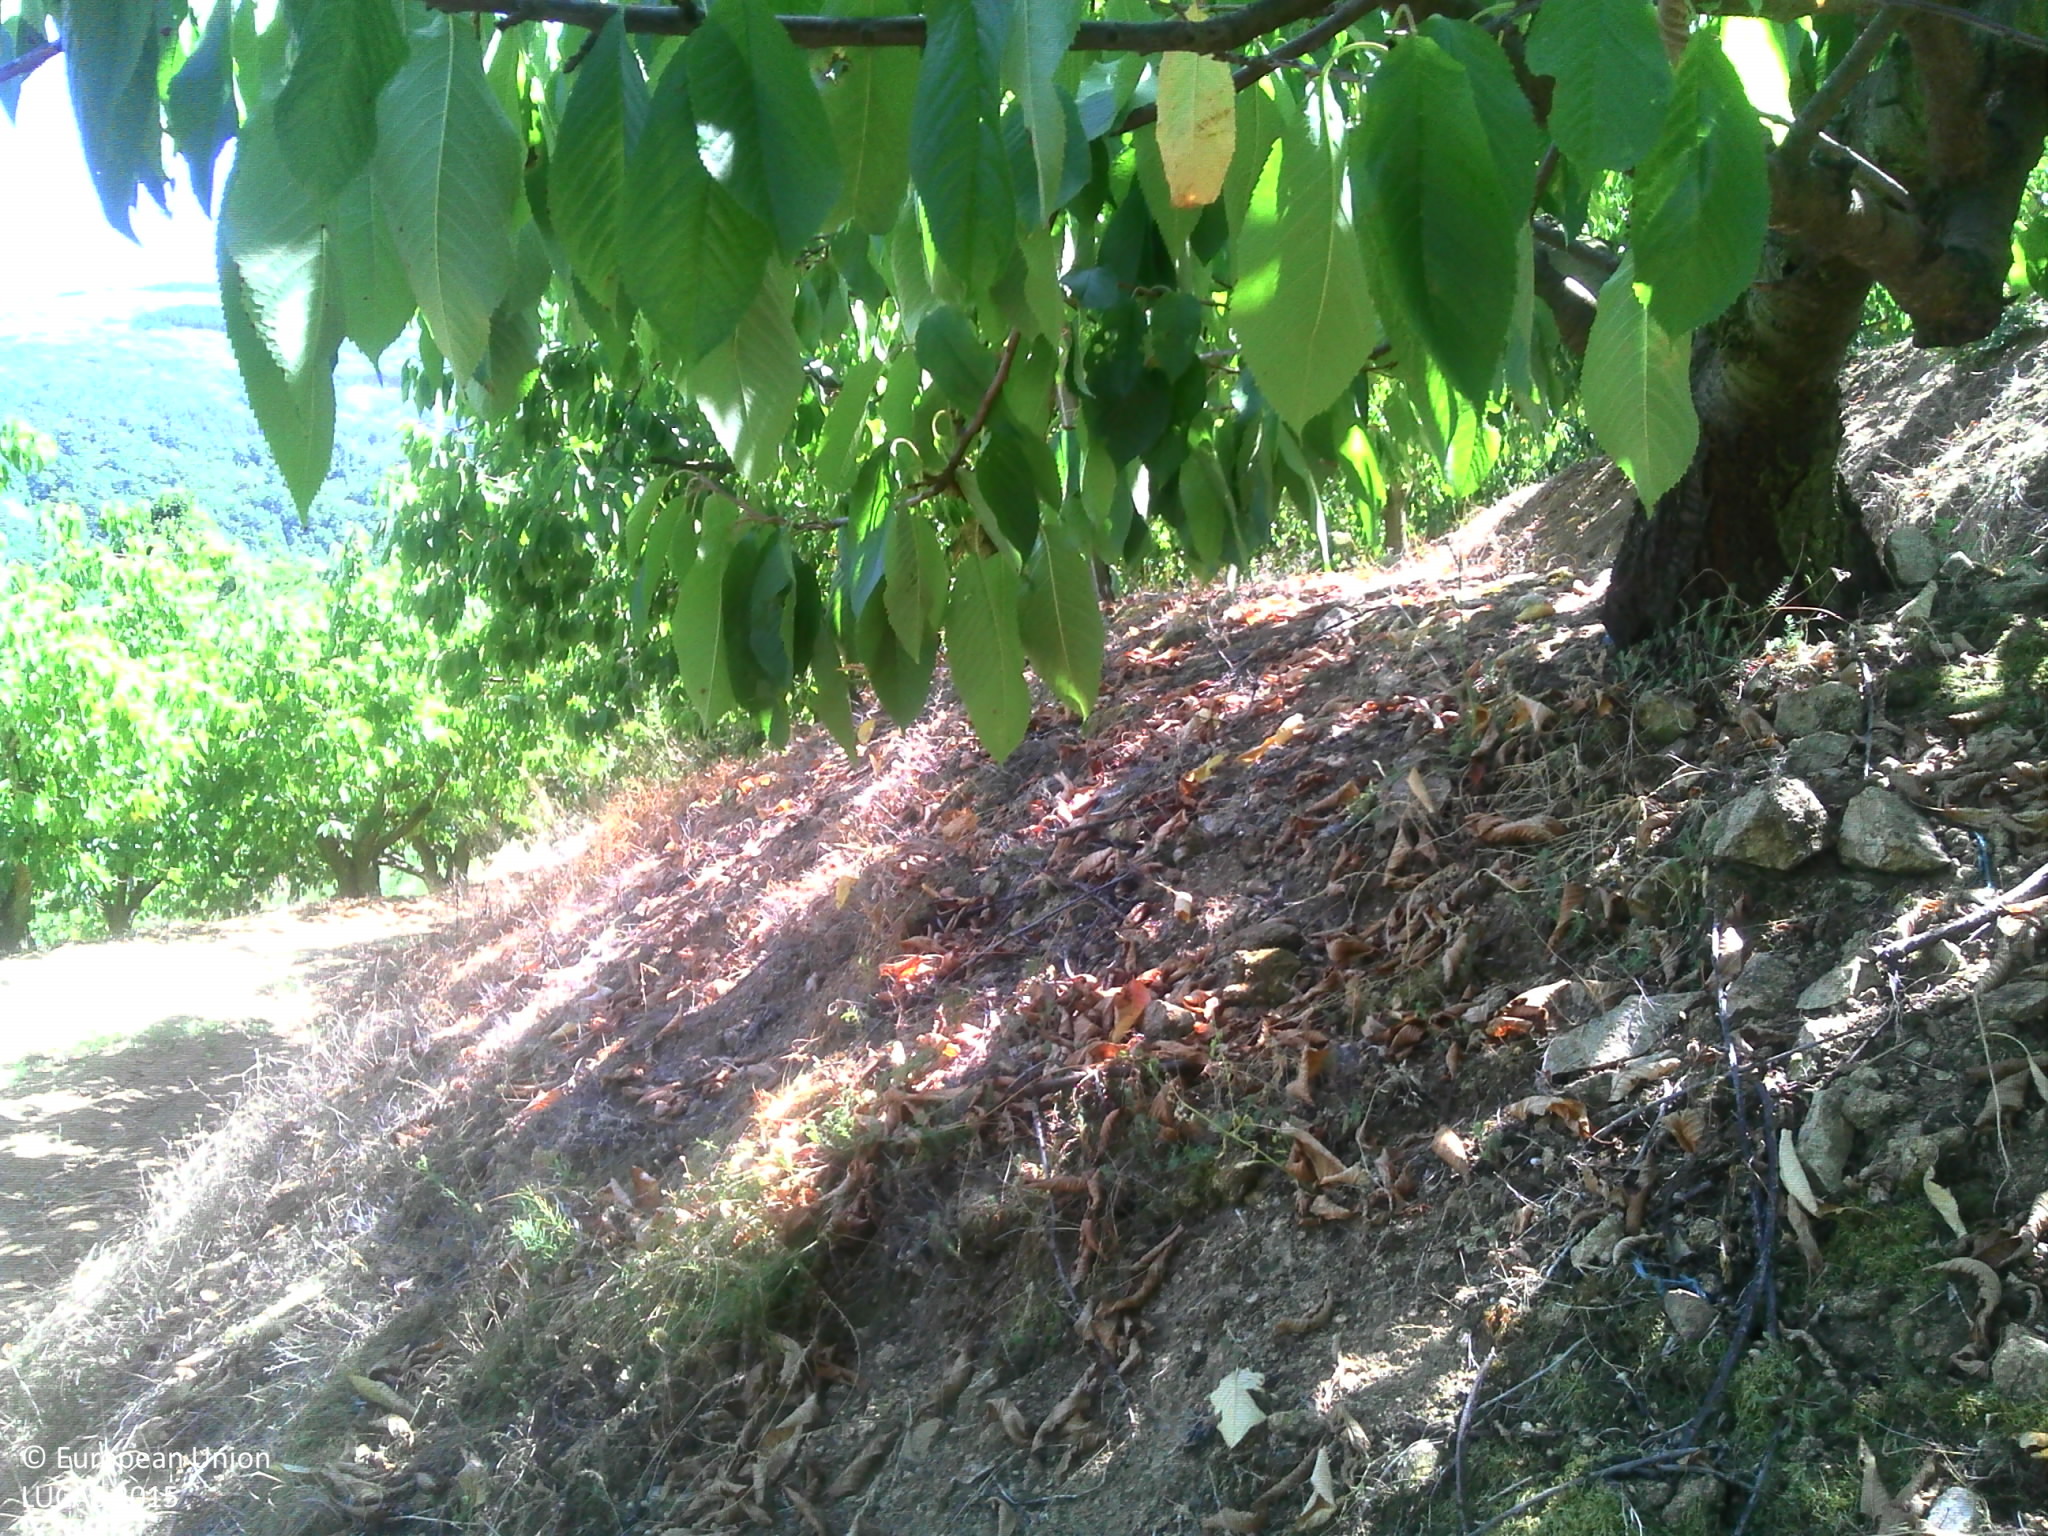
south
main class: Cropland
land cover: Cherry fruit
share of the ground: 50 - 75 %
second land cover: Other bare soil
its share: > 75 %
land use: Agriculture (excluding fallow land and kitchen gardens)
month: July
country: FR
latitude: 45.0249
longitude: 4.6368
